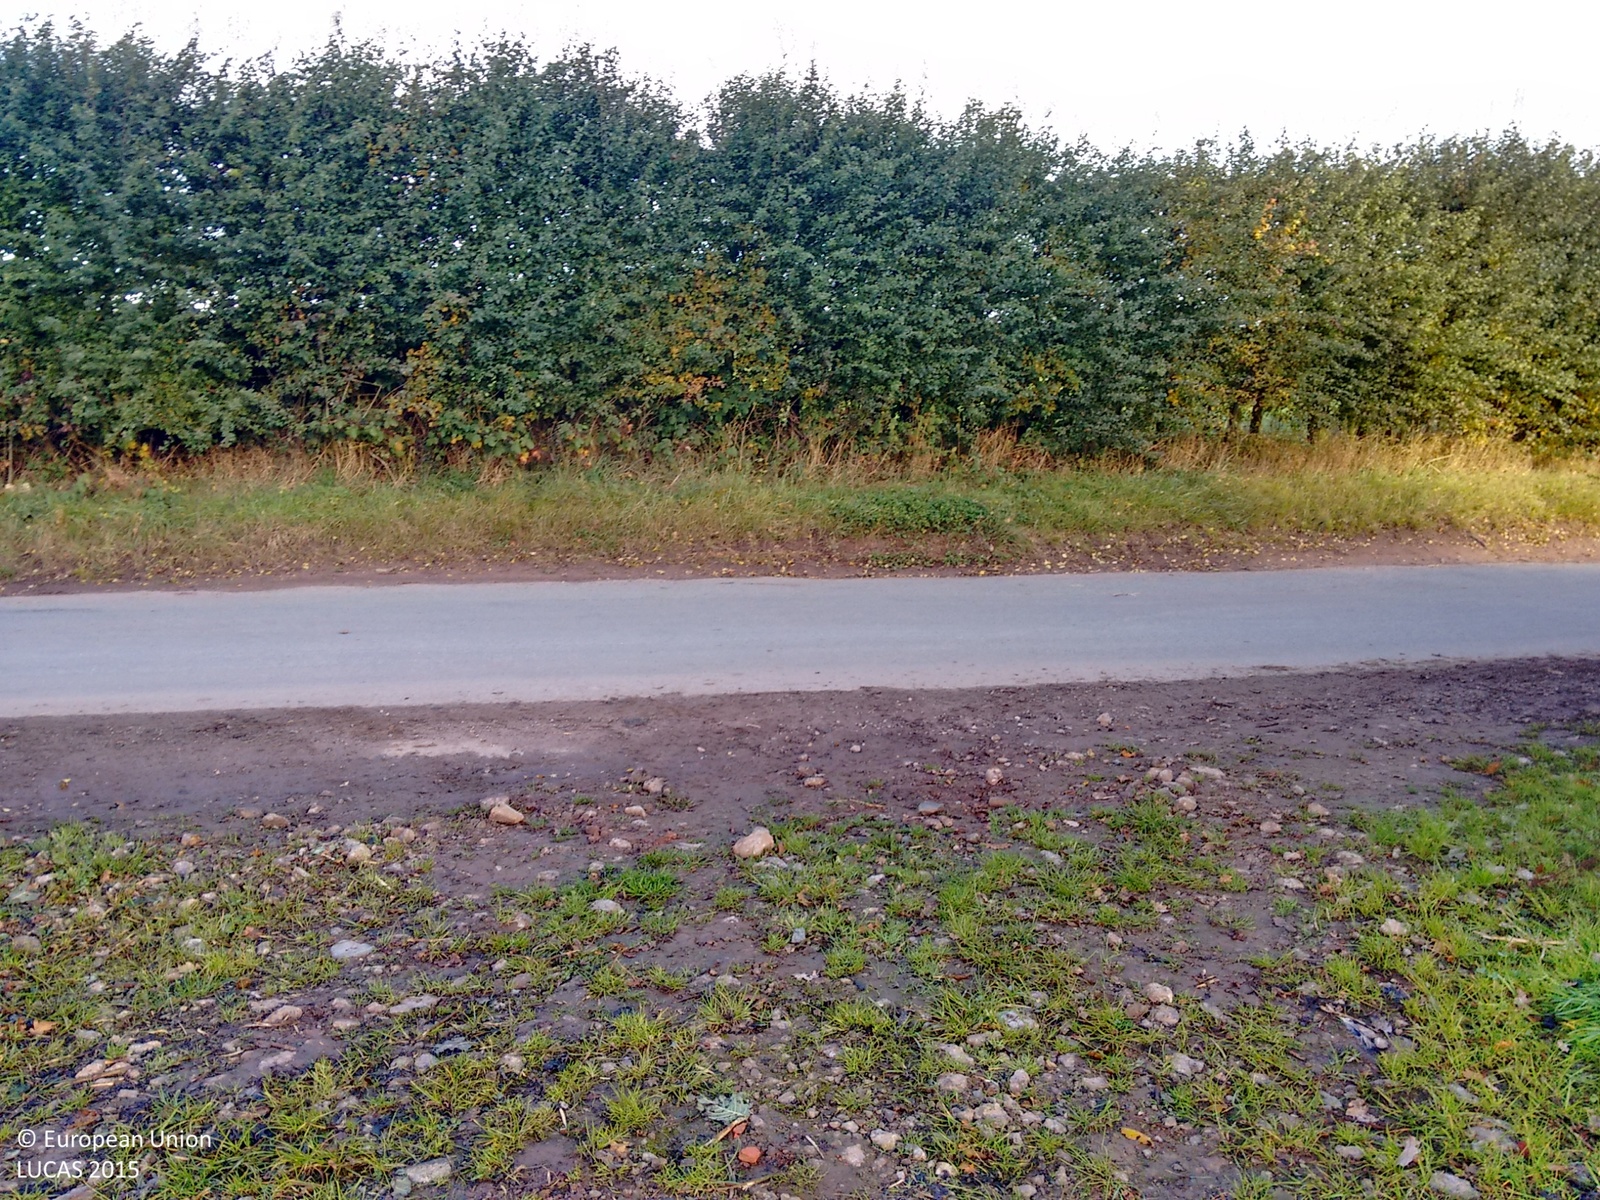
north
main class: Grassland
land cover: Grassland without tree/shrub cover
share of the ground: > 75 %
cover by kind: herbaceous plants 100 %
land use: Agriculture (excluding fallow land and kitchen gardens)
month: October
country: GB
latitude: 52.7795
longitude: -2.7458
